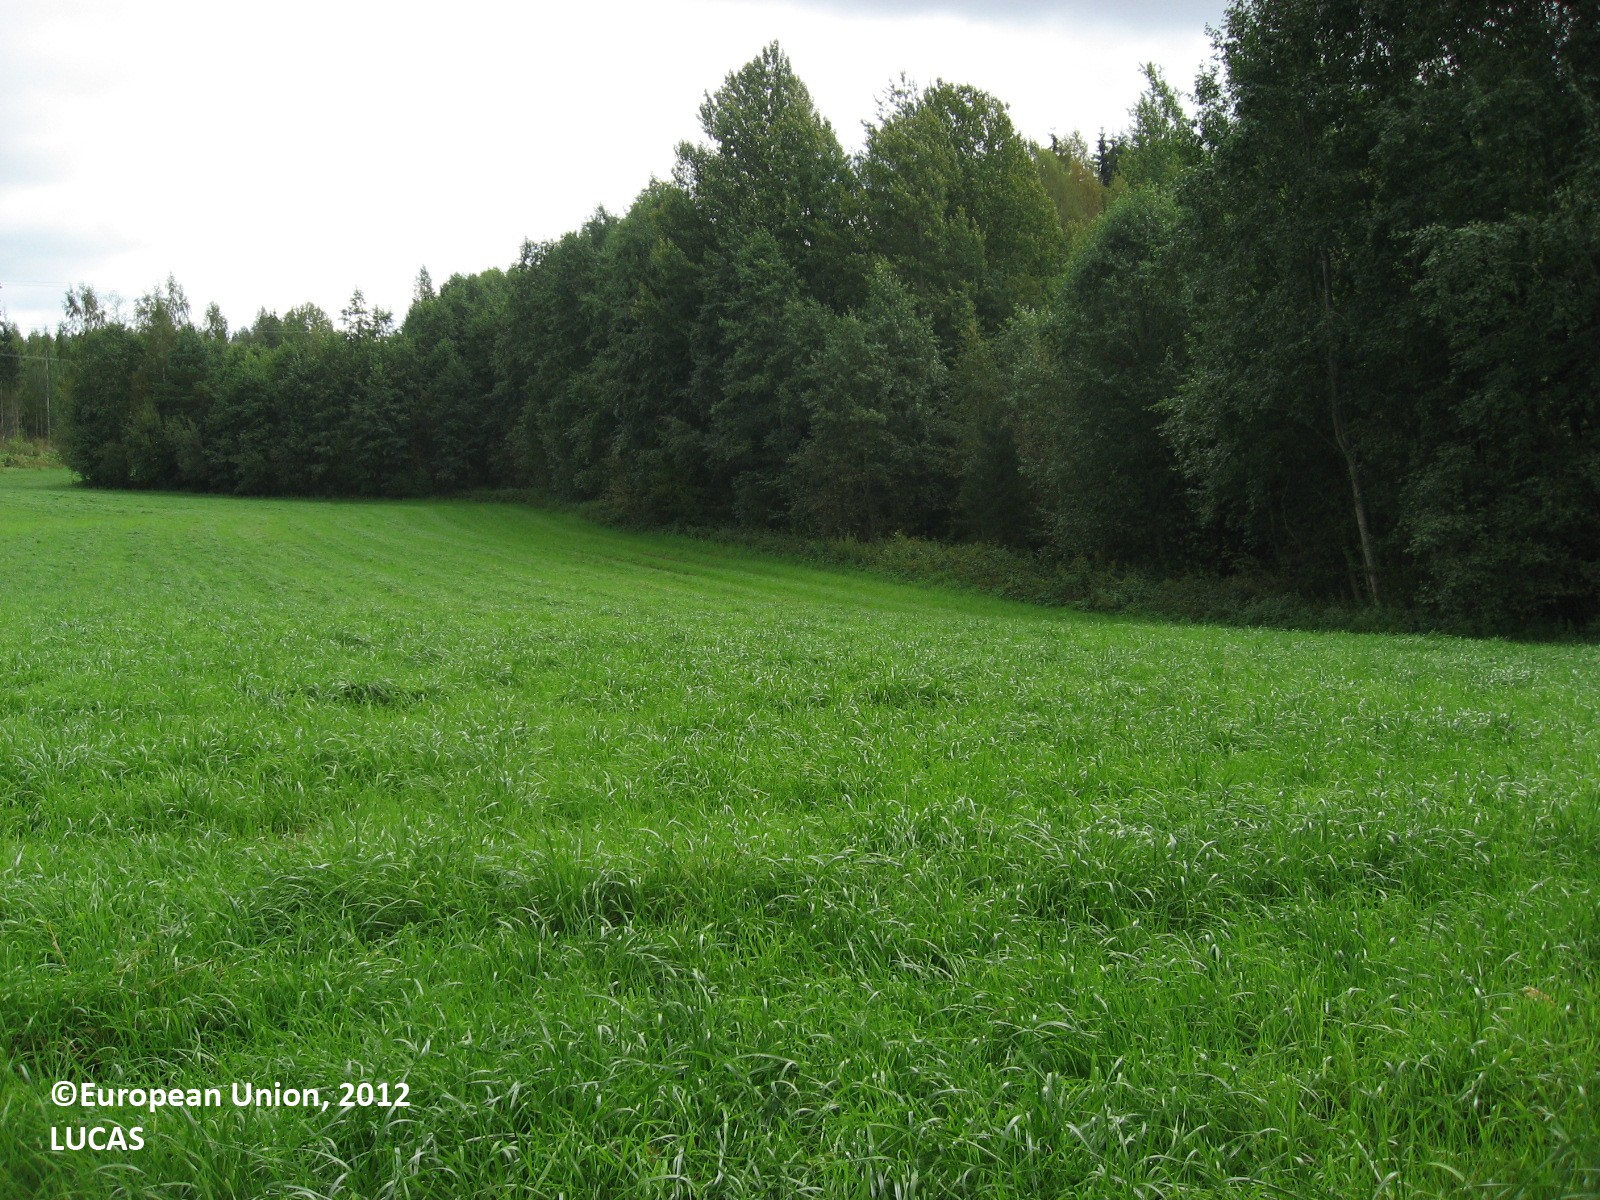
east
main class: Cropland
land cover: Temporary grasslands
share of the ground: > 75 %
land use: Agriculture (excluding fallow land and kitchen gardens)
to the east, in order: Temporary grasslands; Other mixed woodland; Electric lines; Other mixed woodland; Electric lines; Other mixed woodland; Spruce dominated mixed woodland; Rivers and streams; Spruce dominated mixed woodland
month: September
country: FI
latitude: 60.8506
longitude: 25.2679
